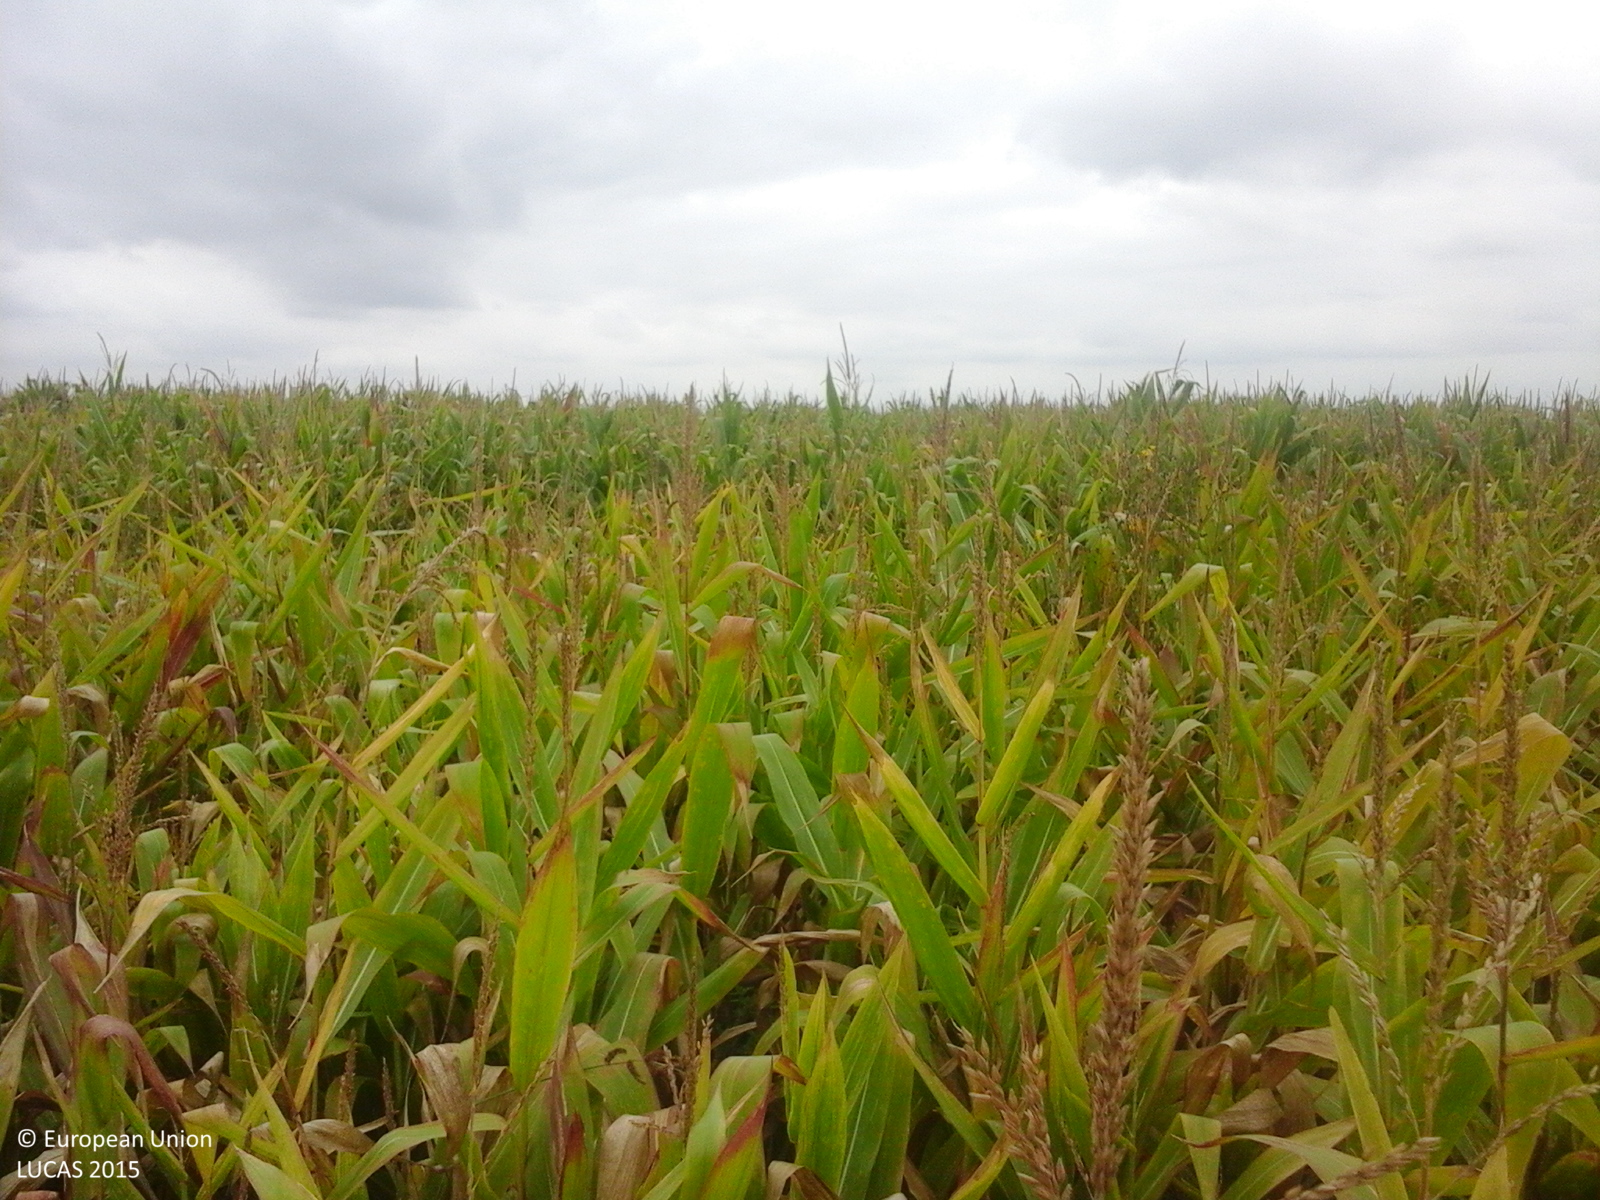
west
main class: Cropland
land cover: Maize
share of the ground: > 75 %
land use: Agriculture (excluding fallow land and kitchen gardens)
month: September
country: RO
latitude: 47.3085
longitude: 22.0196
